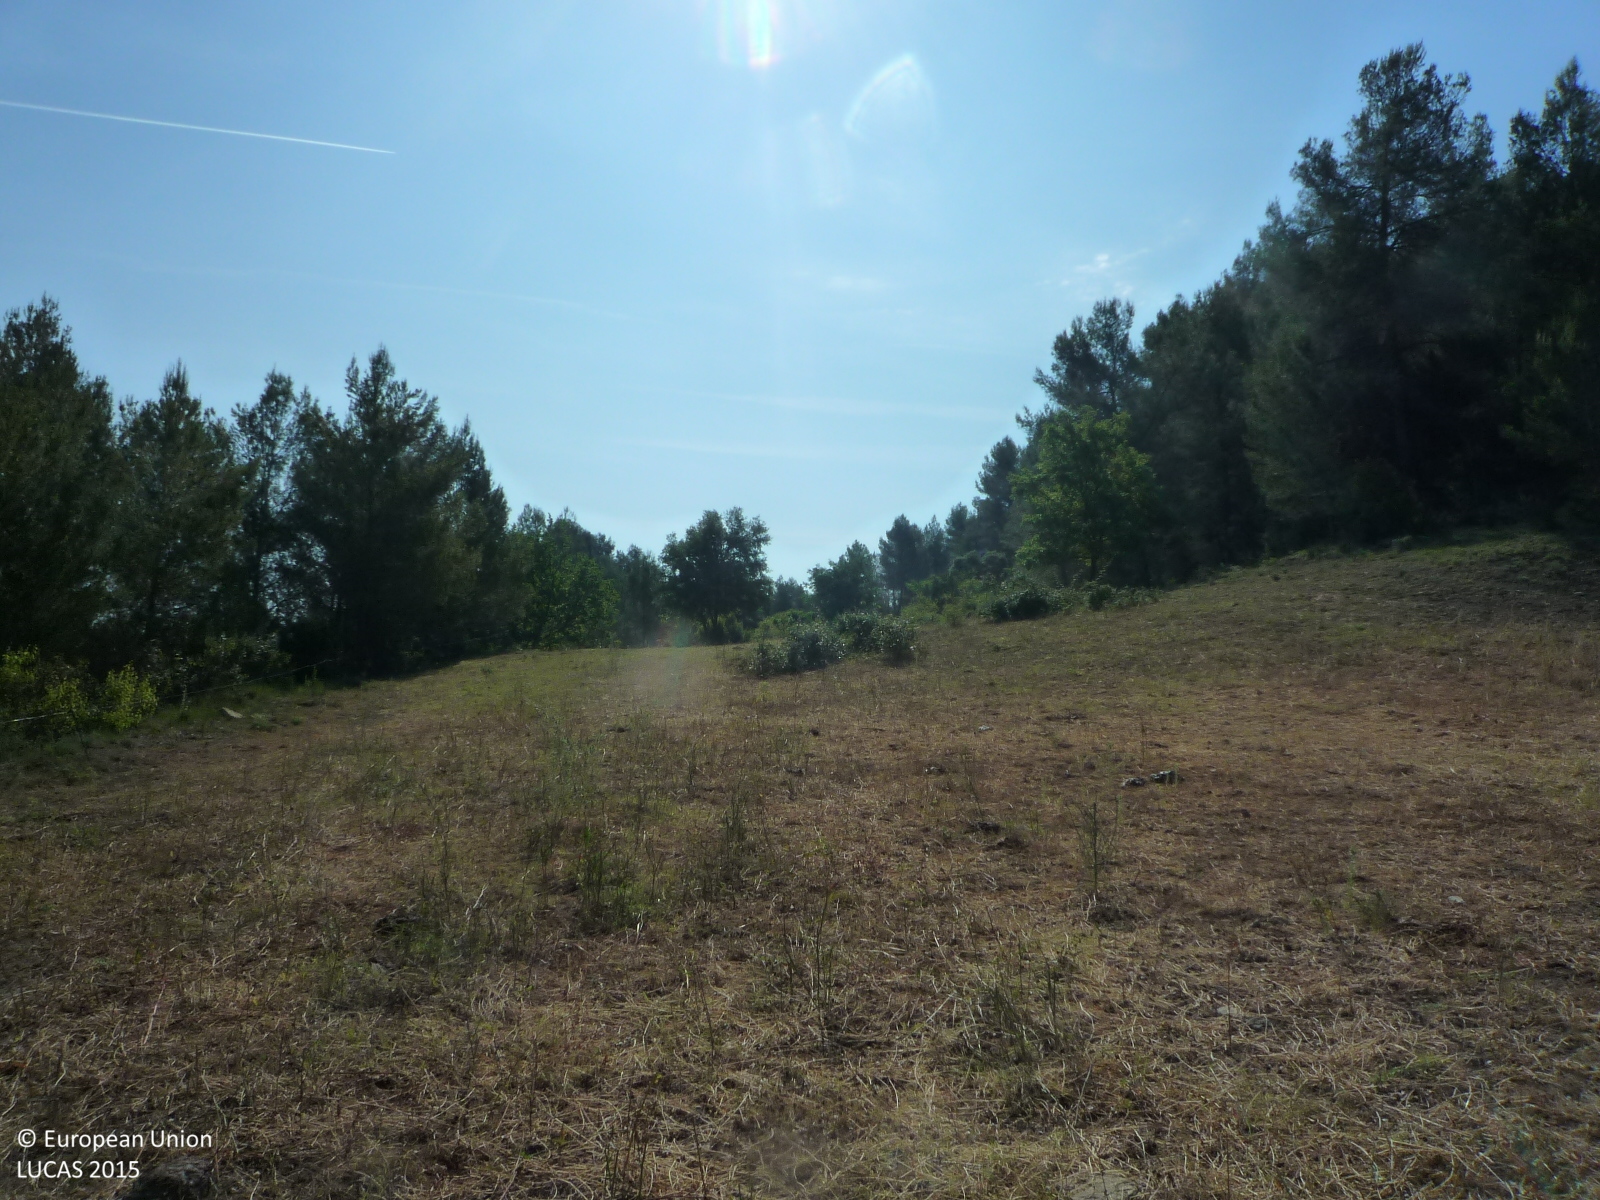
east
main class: Cropland
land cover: Temporary grasslands
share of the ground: > 75 %
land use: Agriculture (excluding fallow land and kitchen gardens)
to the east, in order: Temporary grasslands; Fences; Tracks; Pine dominated coniferous woodland; Tracks; Pine dominated mixed woodland; Artificial constructions in urban areas; Pine dominated mixed woodland; Fences; Pine dominated mixed woodland
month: June
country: ES
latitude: 41.6488
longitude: 1.7908
